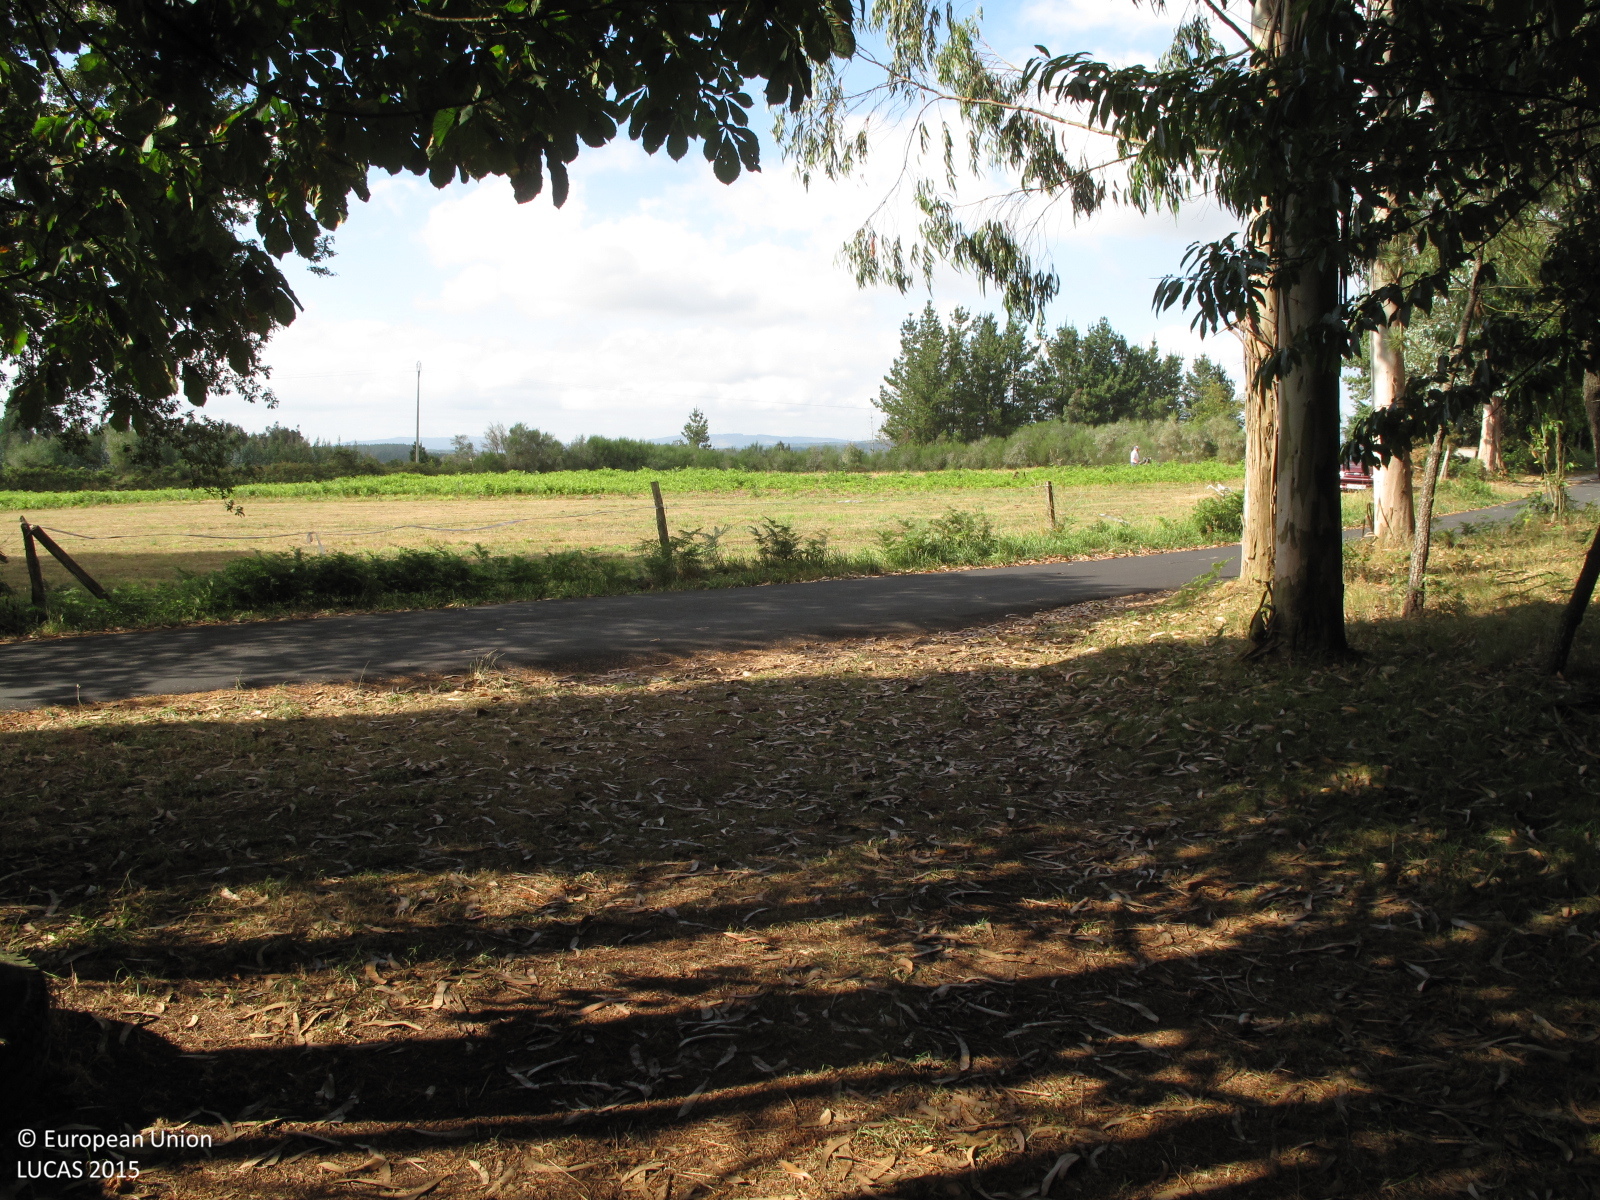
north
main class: Woodland
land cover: Other coniferous woodland
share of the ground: > 75 %
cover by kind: coniferous forest trees 80 %, shrubs 20 %
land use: Community services
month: July
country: ES
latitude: 43.0810
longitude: -7.9613
